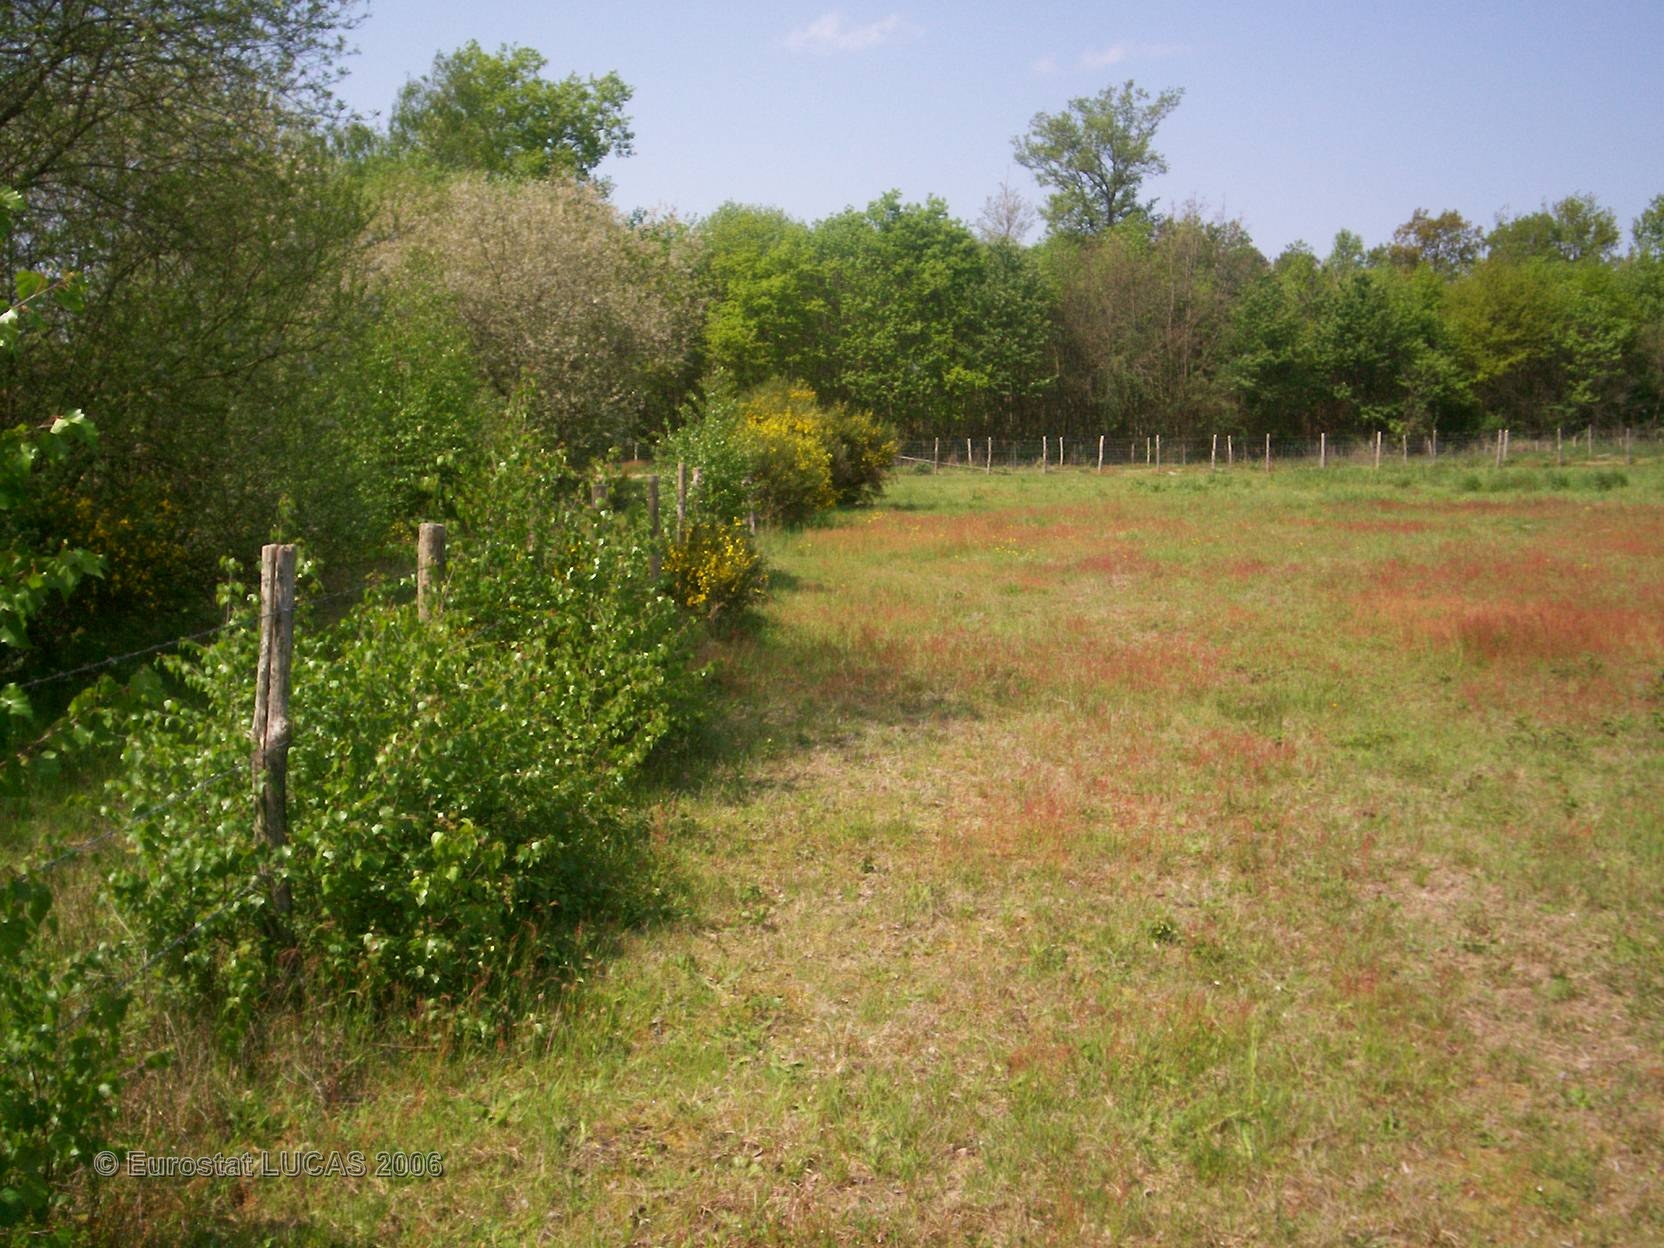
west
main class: Grassland
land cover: Grassland without tree/shrub cover
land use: Agriculture (excluding fallow land and kitchen gardens)
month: May
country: FR
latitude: 47.7673
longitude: 0.1945
